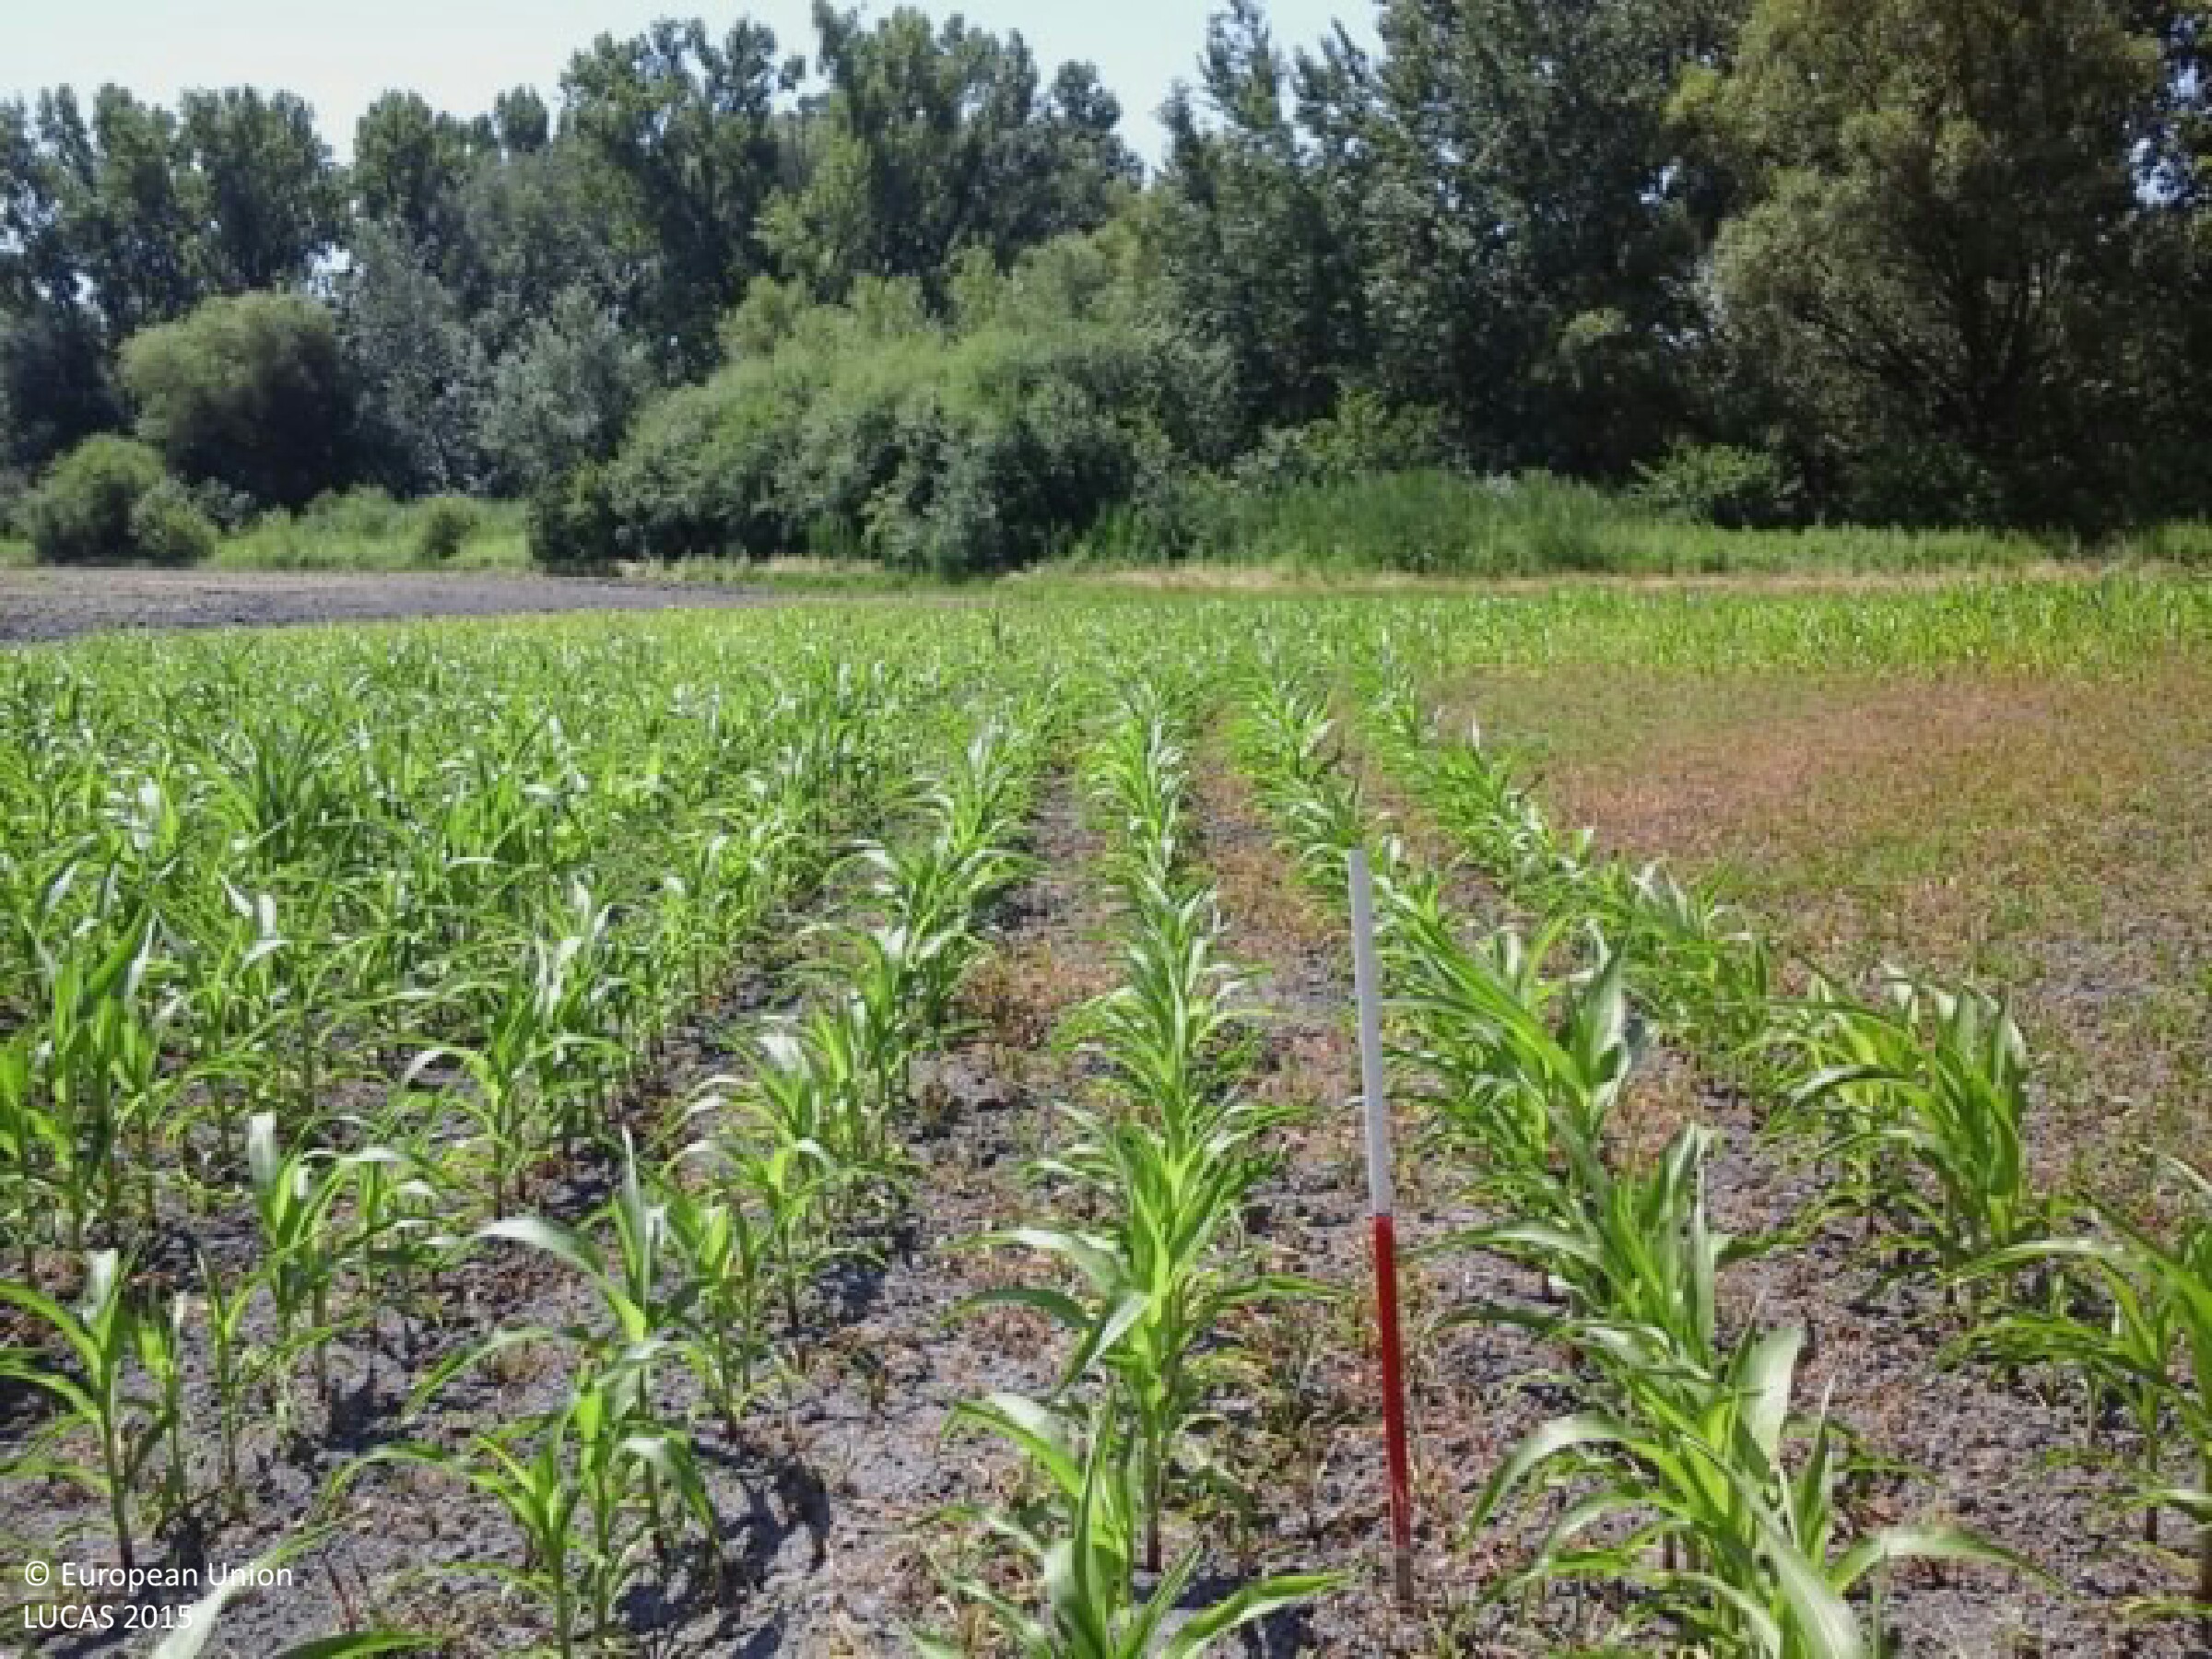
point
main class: Cropland
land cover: Maize
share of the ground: 25 - 50 %
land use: Agriculture (excluding fallow land and kitchen gardens)
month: July
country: HU
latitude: 45.9793
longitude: 18.9042
